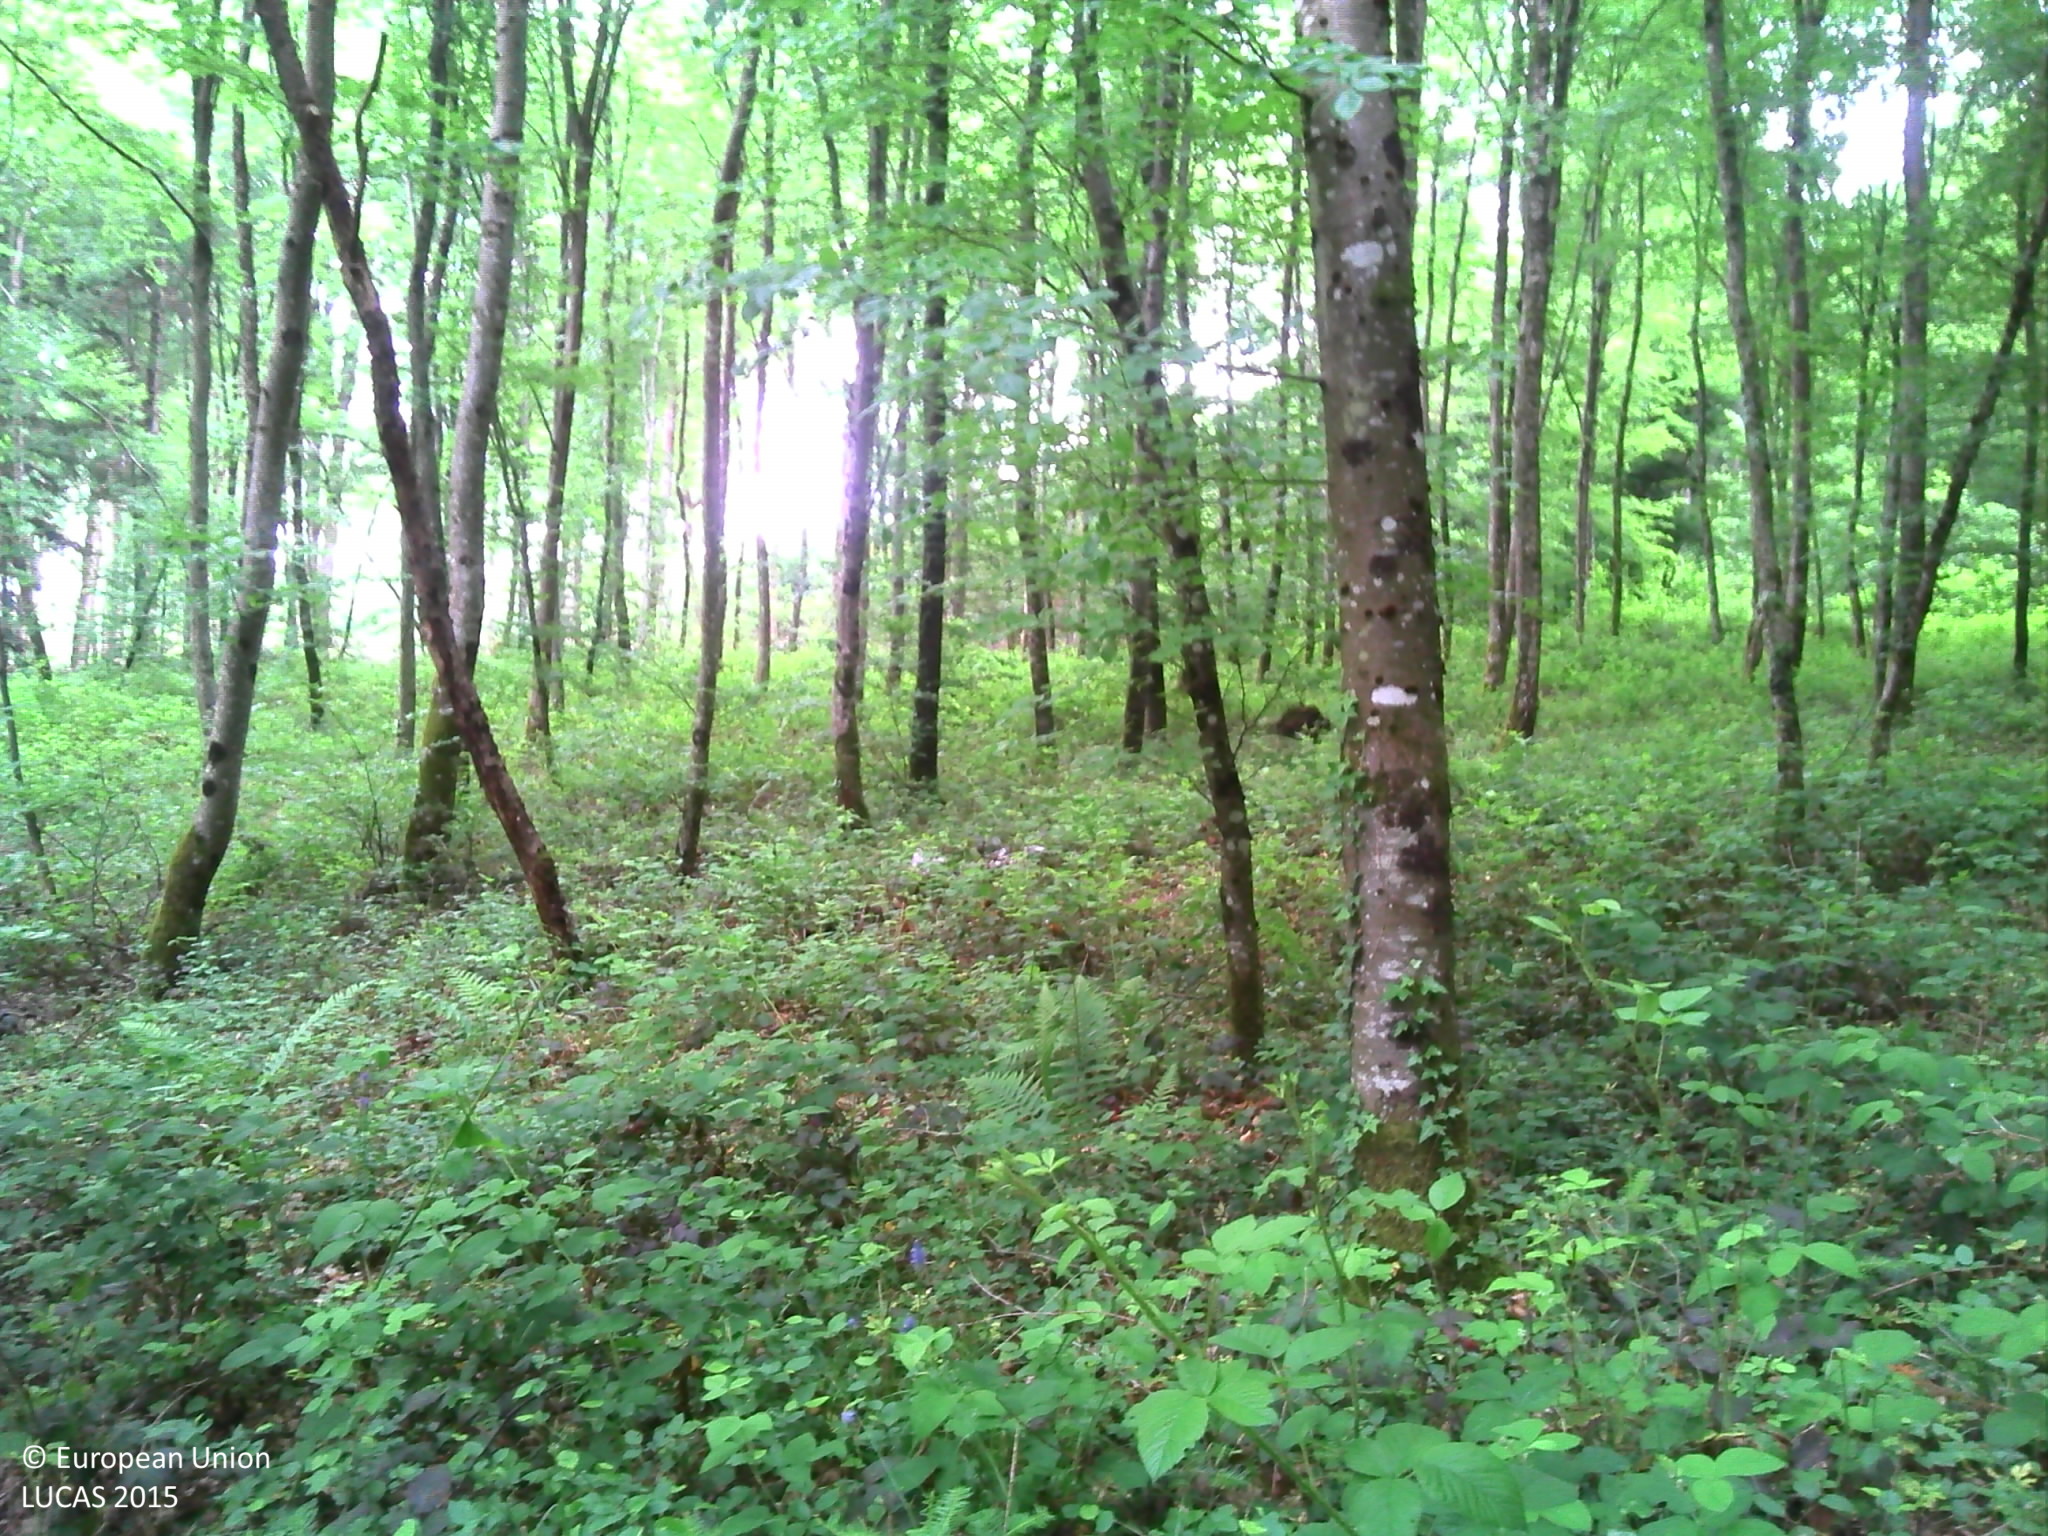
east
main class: Woodland
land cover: Broadleaved woodland
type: beech forest
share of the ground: > 75 %
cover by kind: broadleaved forest trees 90 %, herbaceous plants 10 %
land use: Forestry
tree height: > 5 m
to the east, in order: Broadleaved woodland; Tracks; Broadleaved woodland; Tracks; Broadleaved woodland
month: May
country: FR
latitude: 47.8629
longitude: 6.0040
